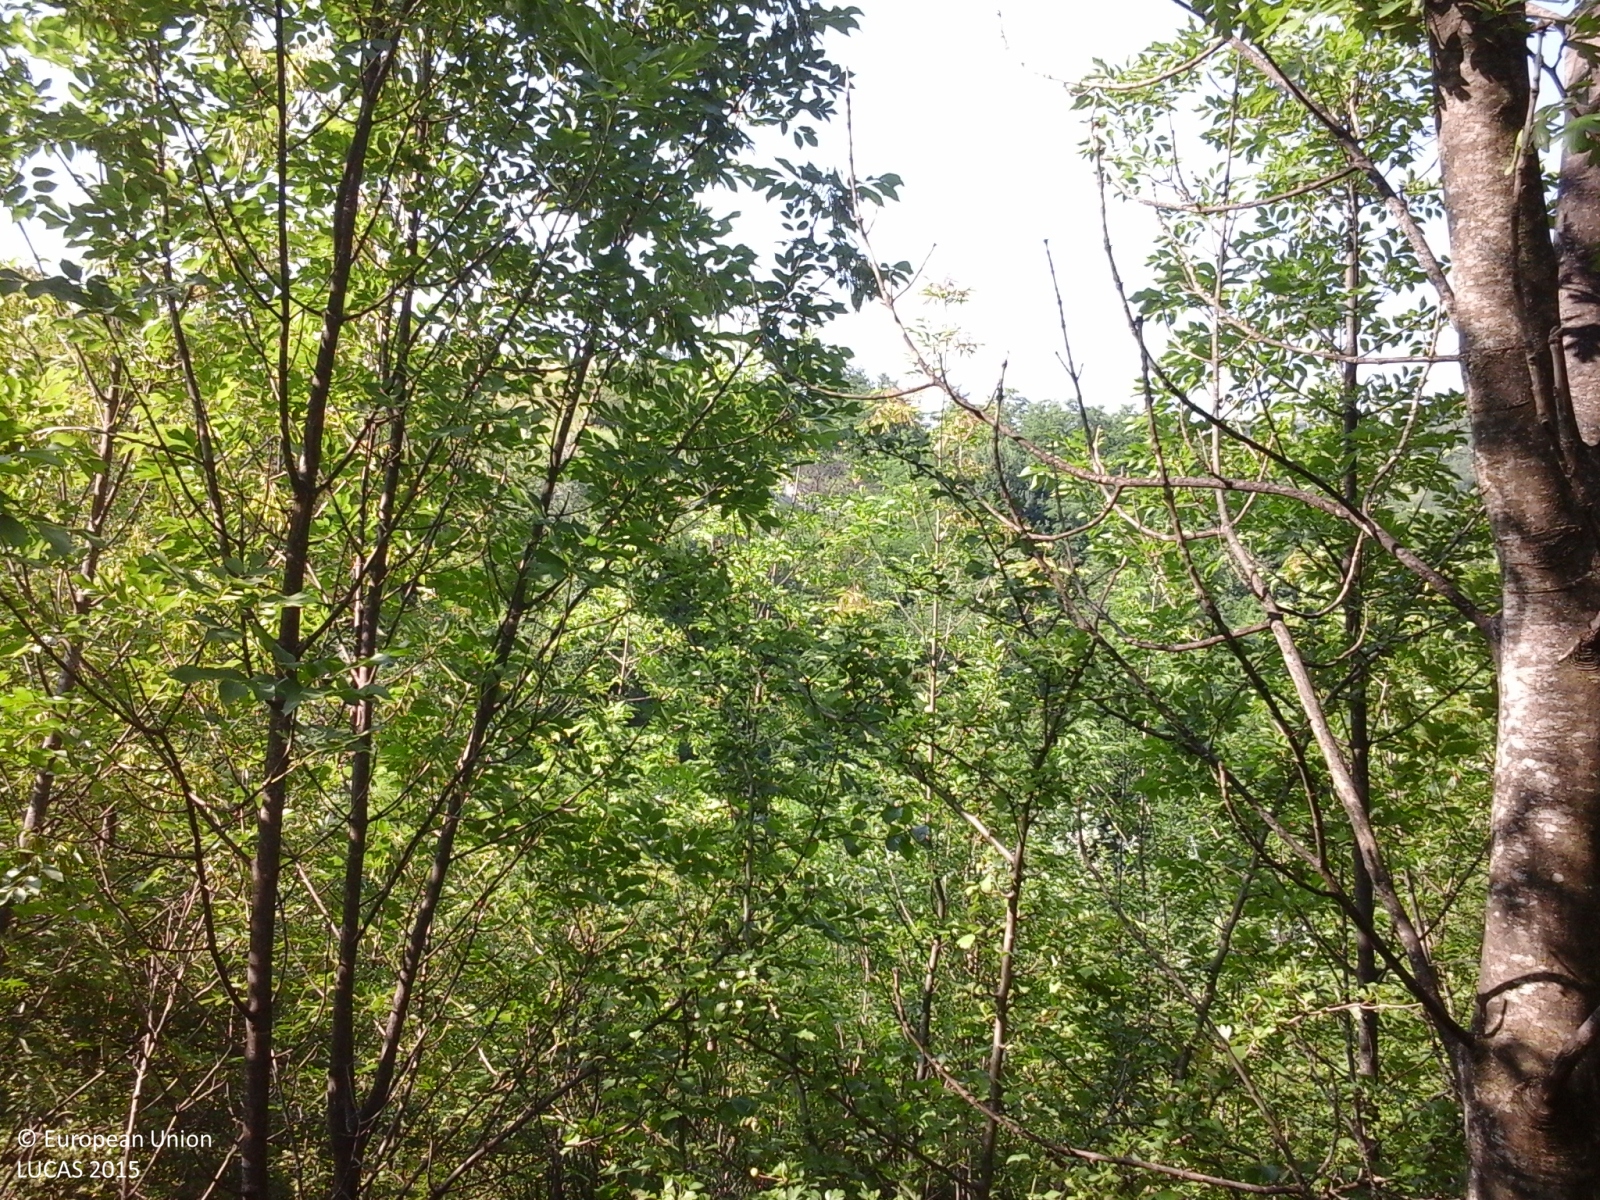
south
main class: Woodland
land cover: Broadleaved woodland
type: thermophilous deciduous forest
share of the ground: > 75 %
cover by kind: broadleaved forest trees 80 %, shrubs 10 %, herbaceous plants 10 %
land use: Abandoned areas
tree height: < 5 m
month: June
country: IT
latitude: 44.6677
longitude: 8.7539
